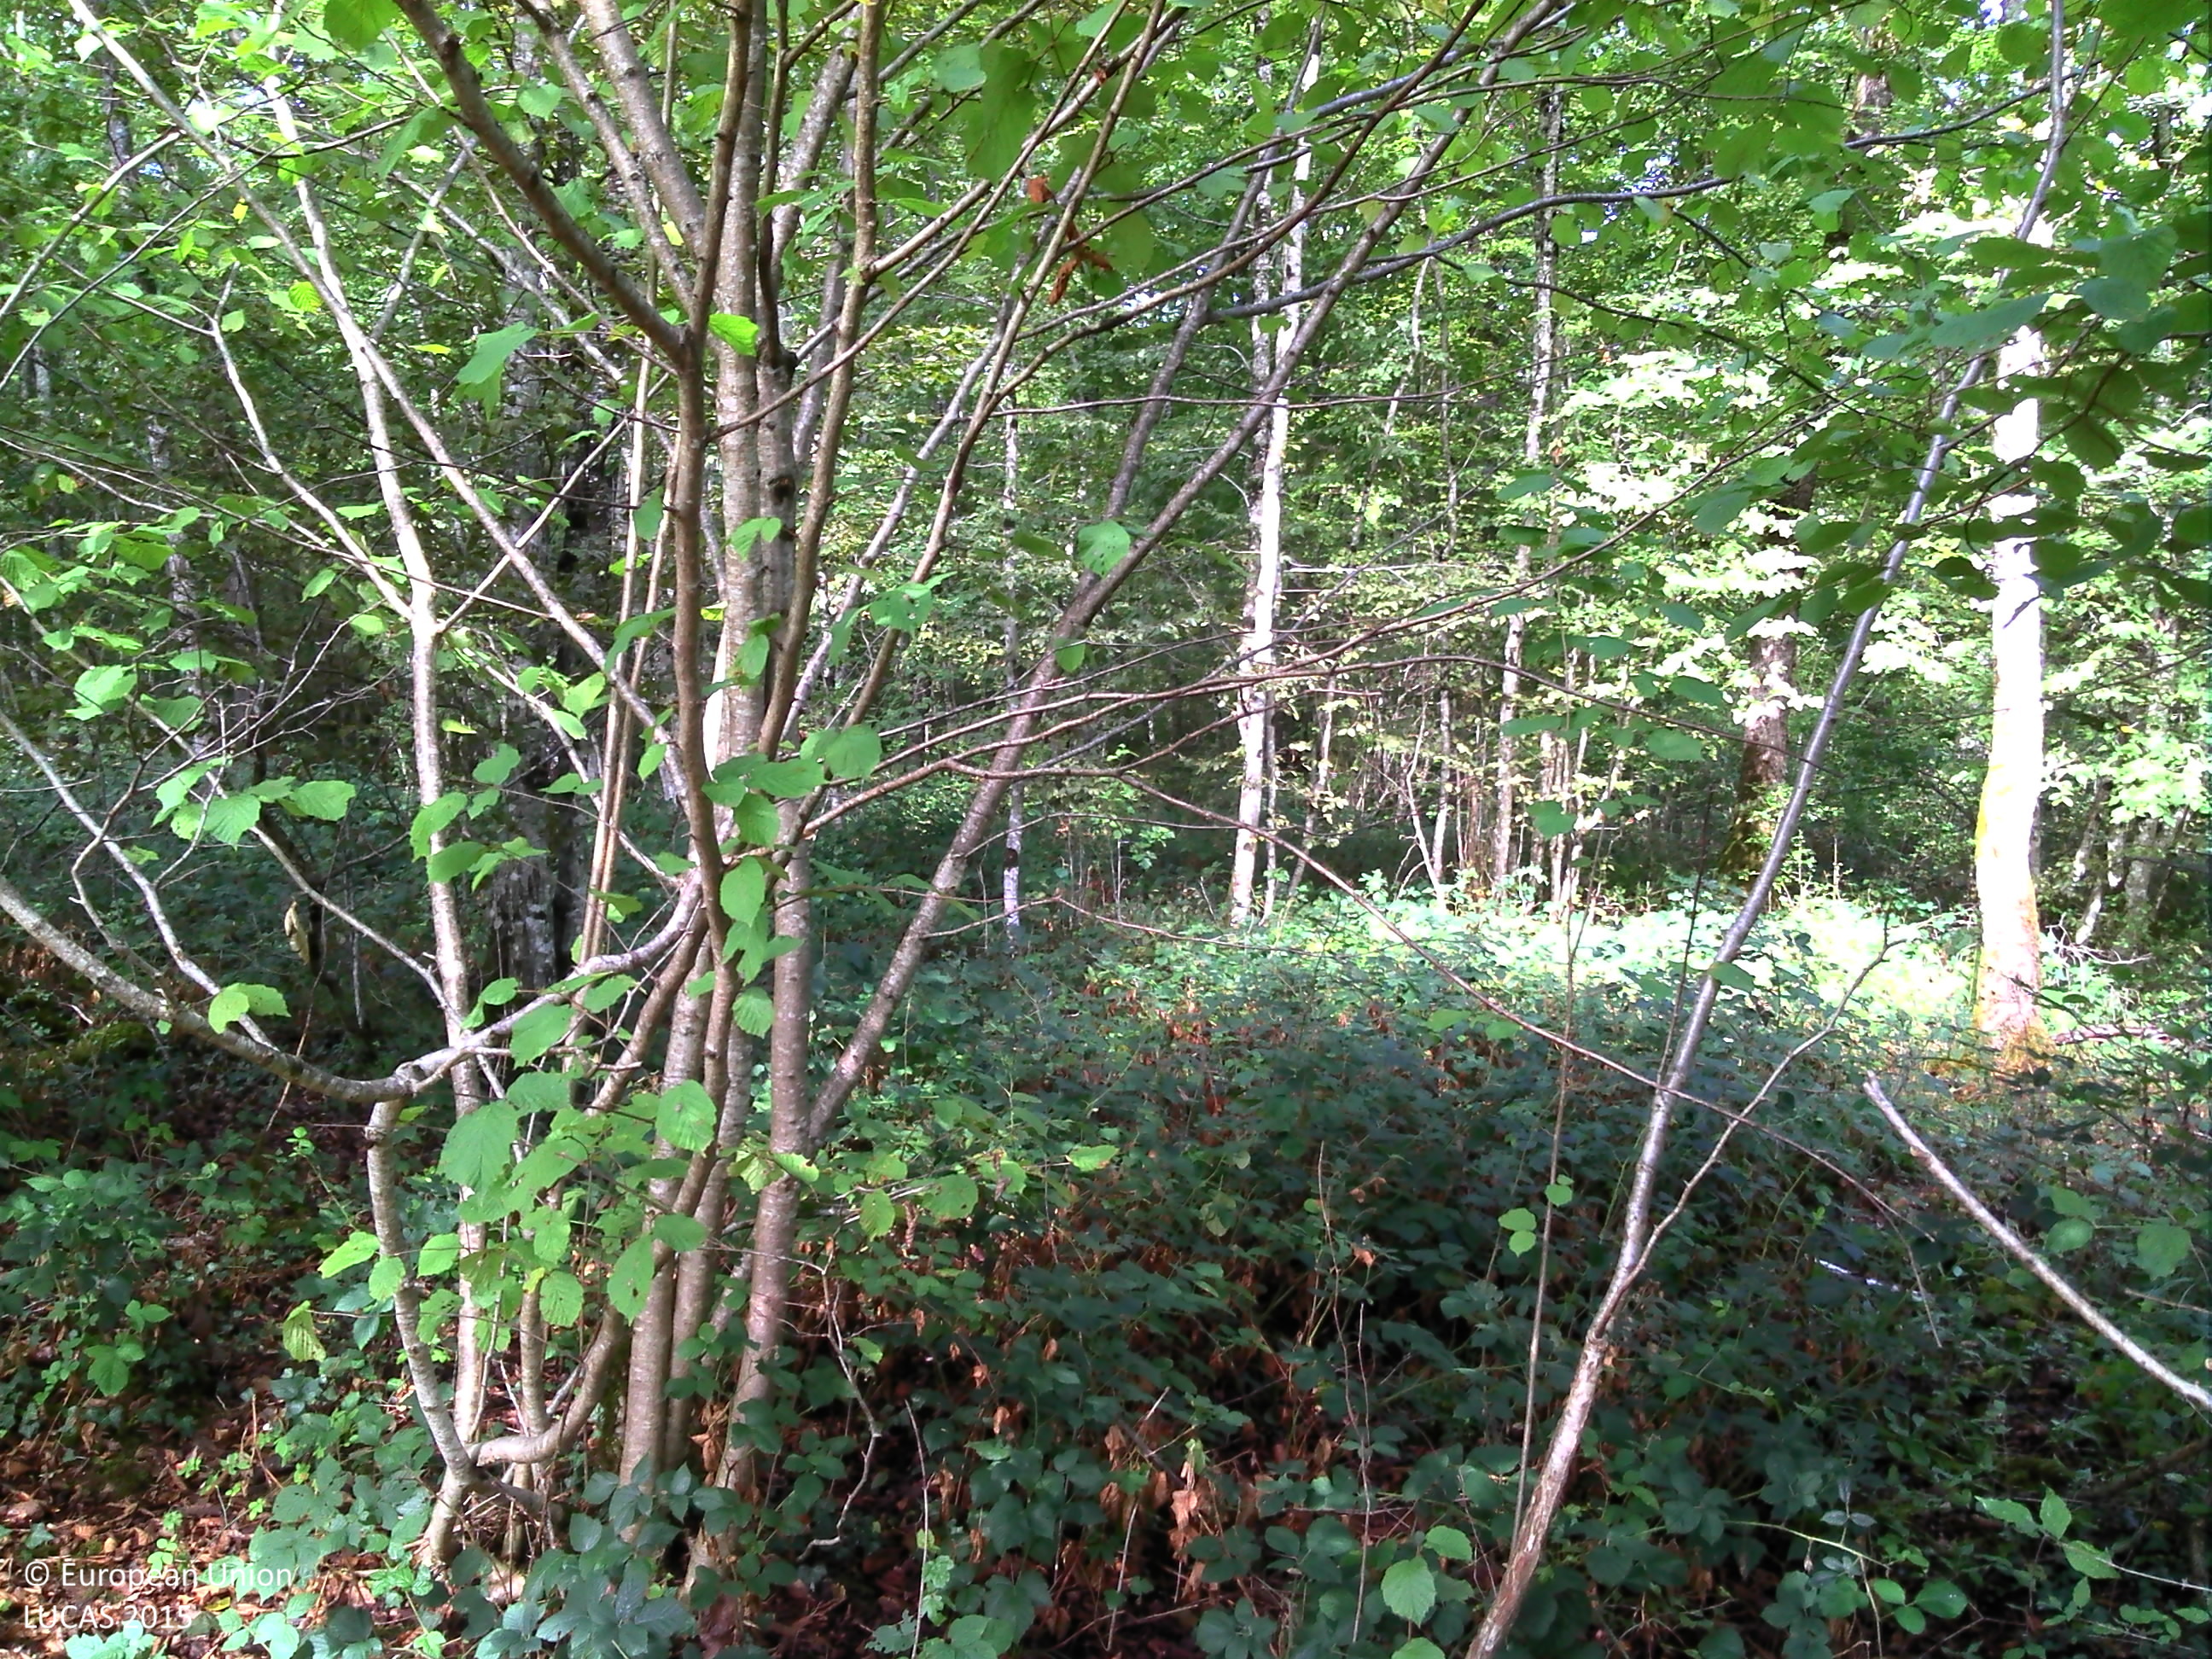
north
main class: Woodland
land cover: Broadleaved woodland
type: mesophytic deciduous forest
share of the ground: > 75 %
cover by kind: broadleaved forest trees 90 %, herbaceous plants 10 %
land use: Forestry
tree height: > 5 m
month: September
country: FR
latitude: 48.0587
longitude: 4.6715
